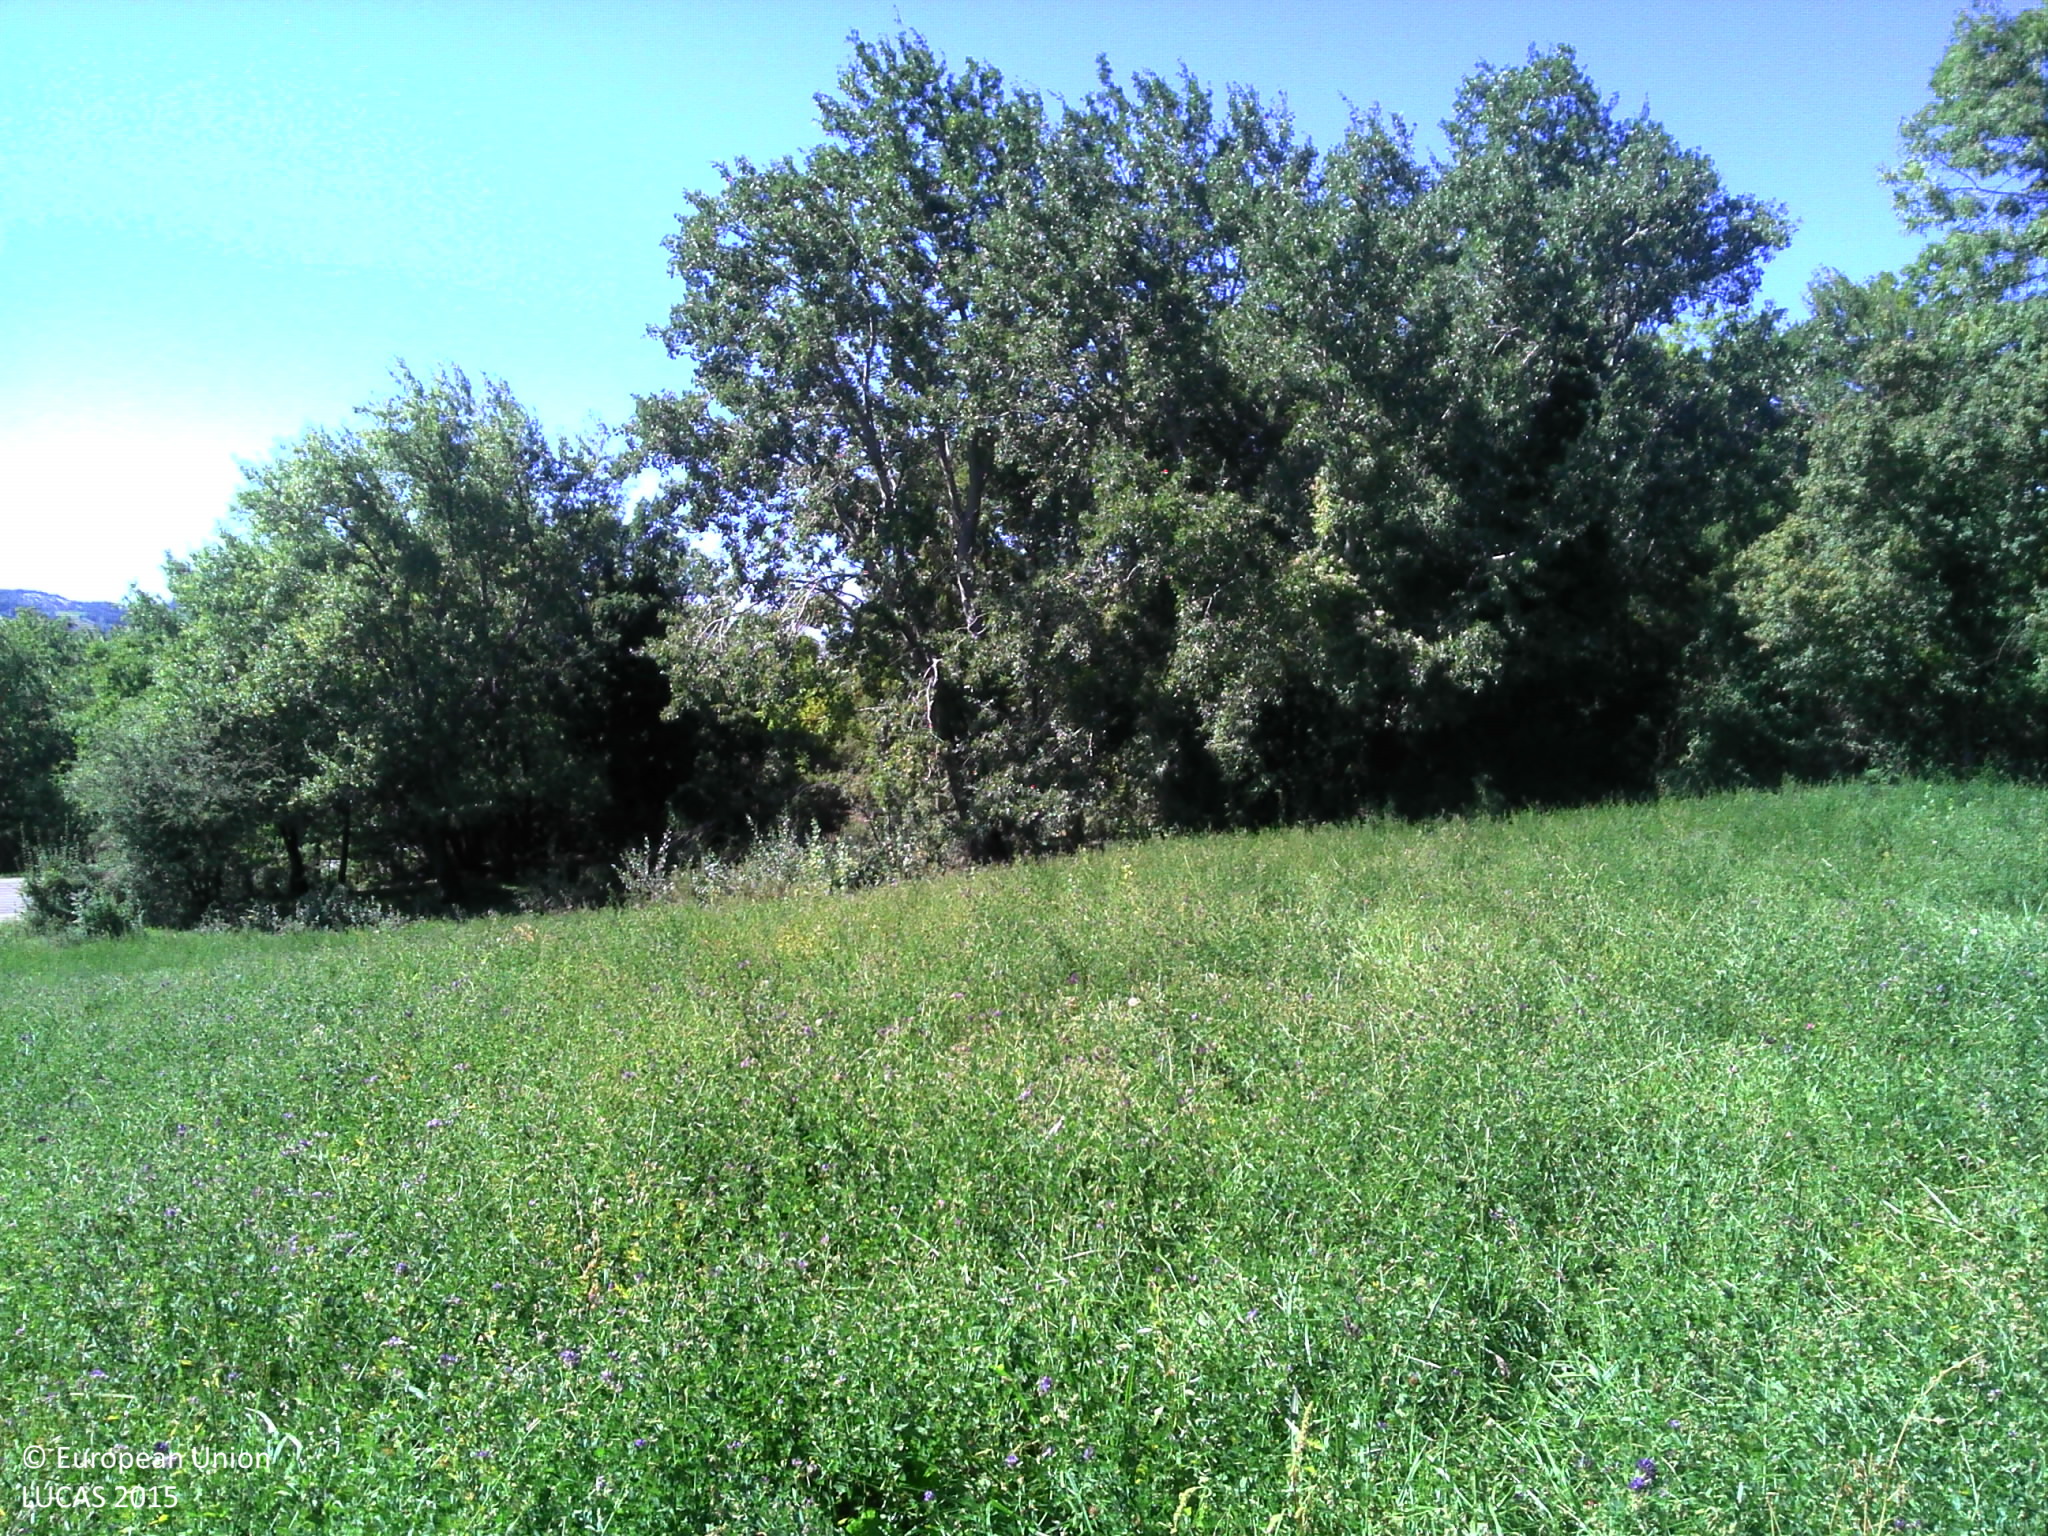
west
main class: Cropland
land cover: Lucerne
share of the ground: > 75 %
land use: Agriculture (excluding fallow land and kitchen gardens)
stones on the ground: < 10 %
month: September
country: FR
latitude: 44.5704
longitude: 6.2163
